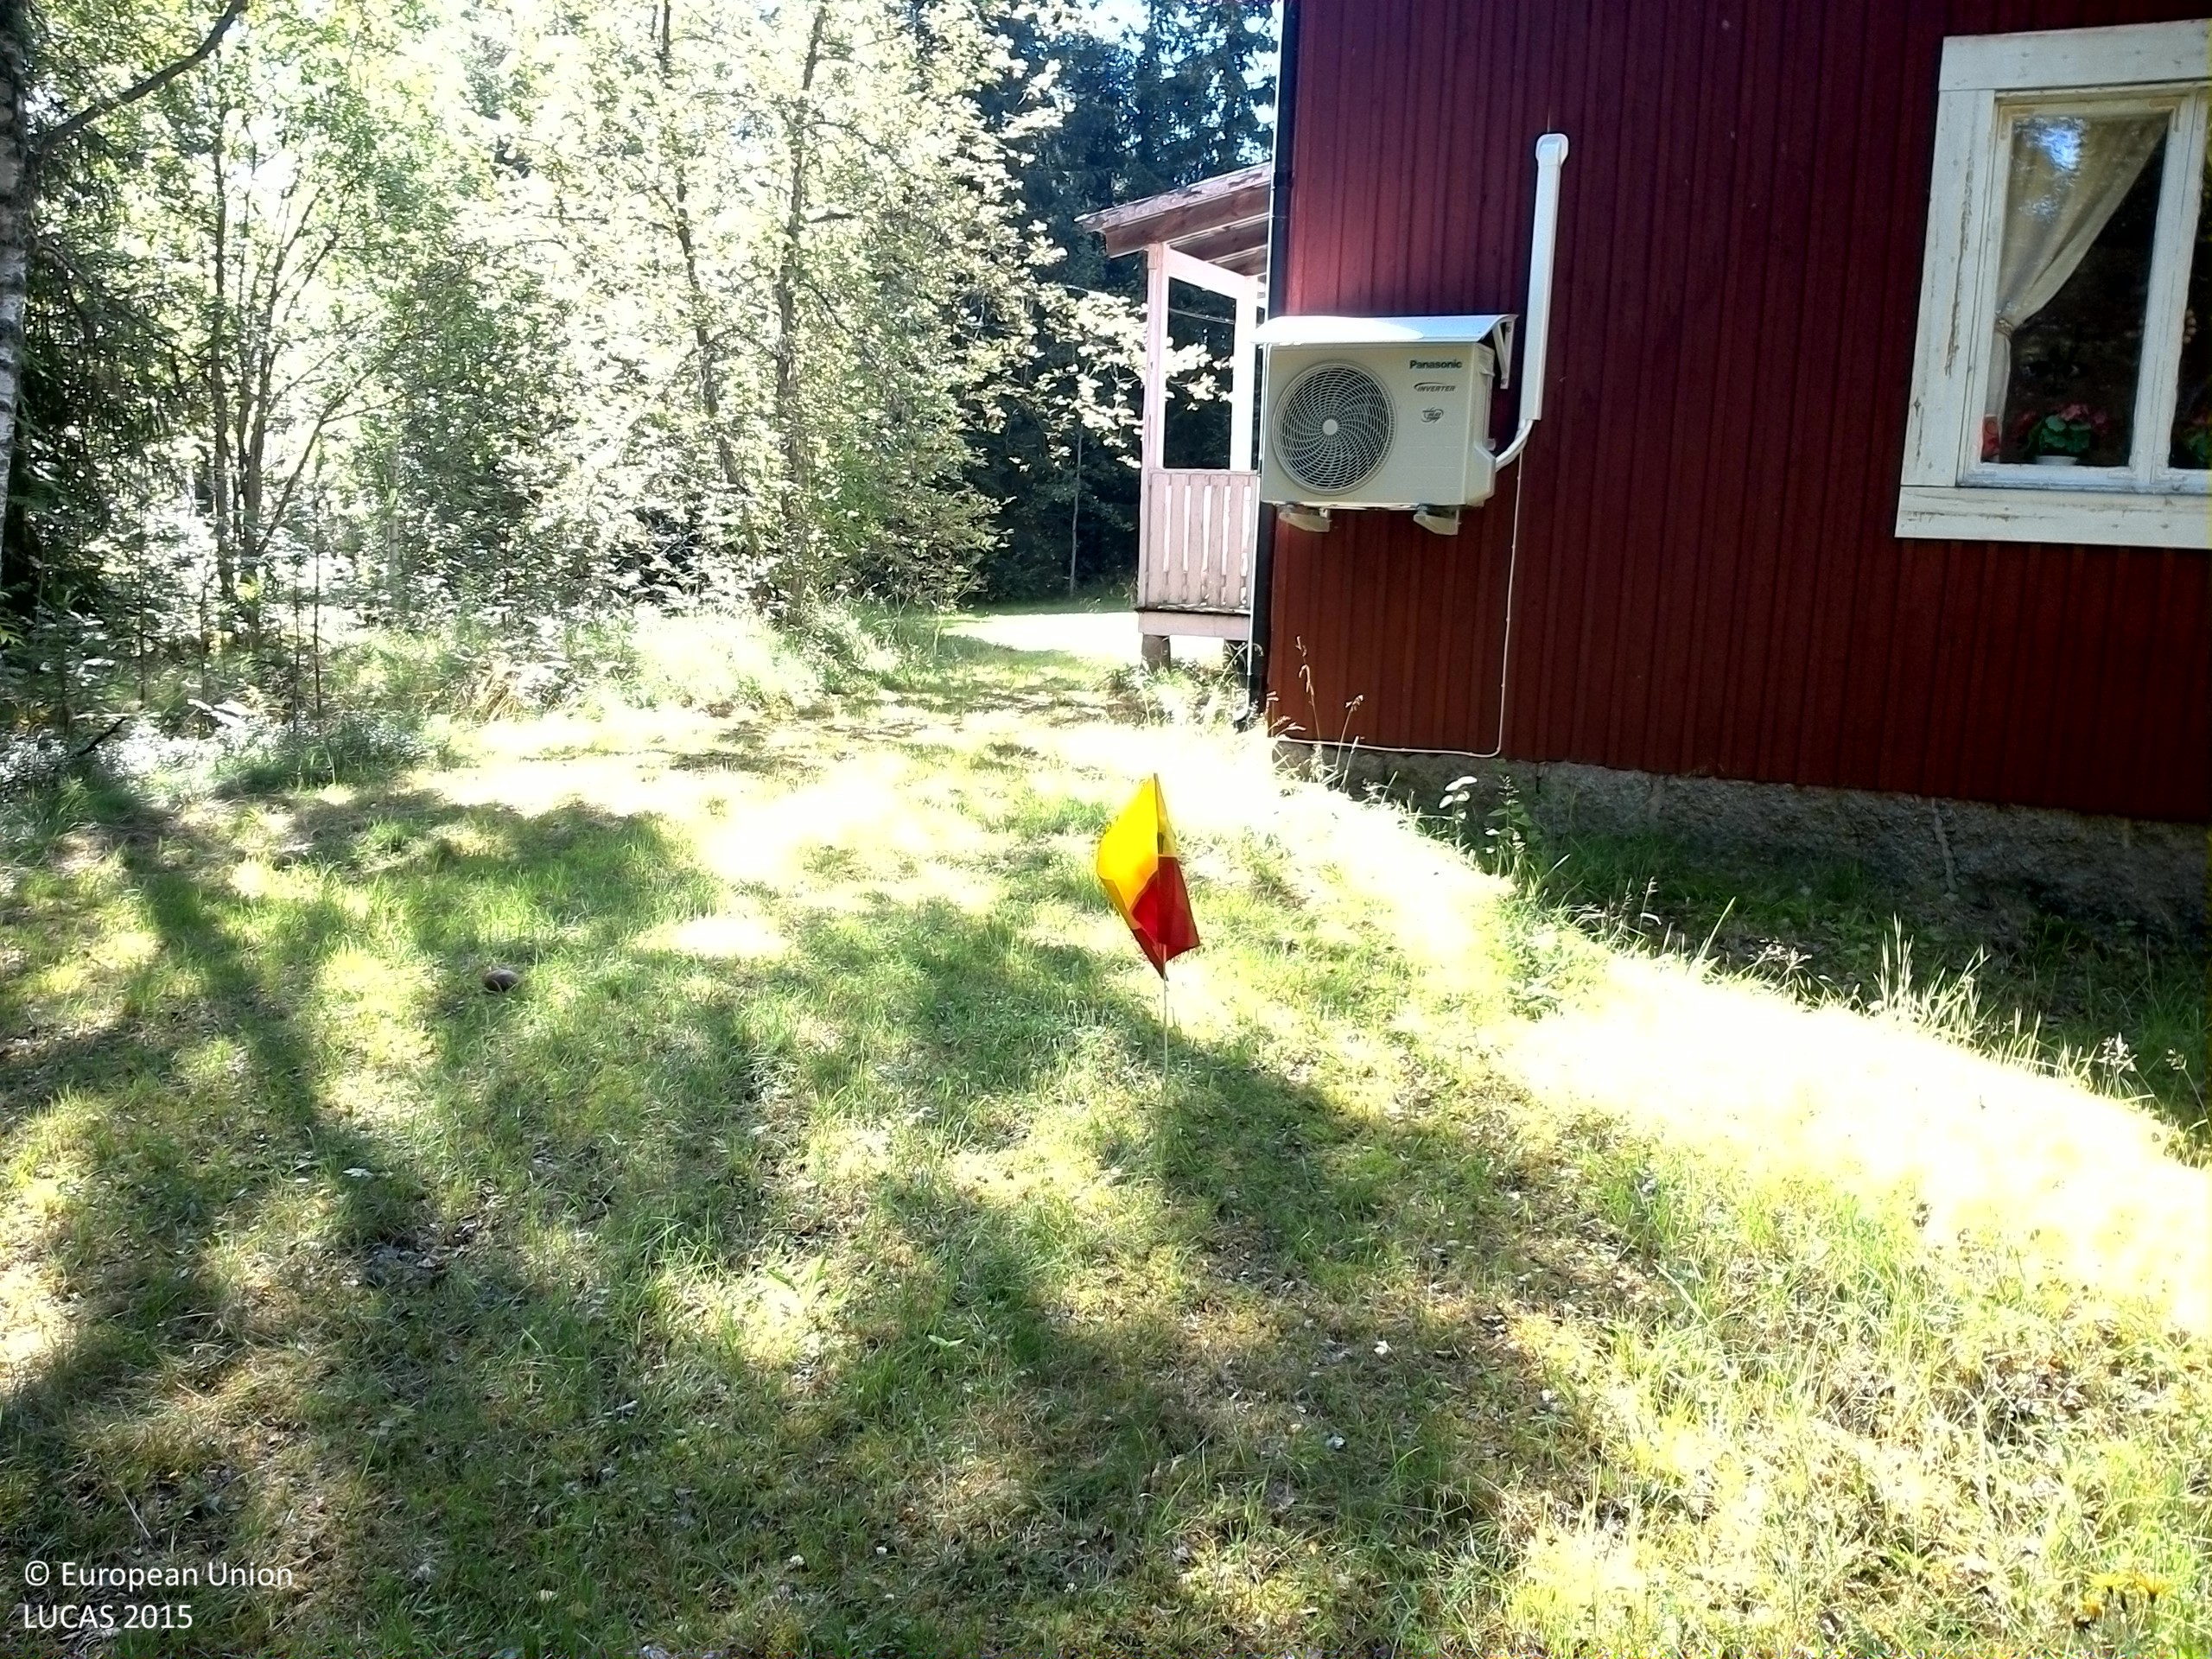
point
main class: Grassland
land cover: Grassland without tree/shrub cover
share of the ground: > 75 %
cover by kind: herbaceous plants 75 %, lichens and mosses 25 %
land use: Residential
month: August
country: SE
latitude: 63.7977
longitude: 16.4070
